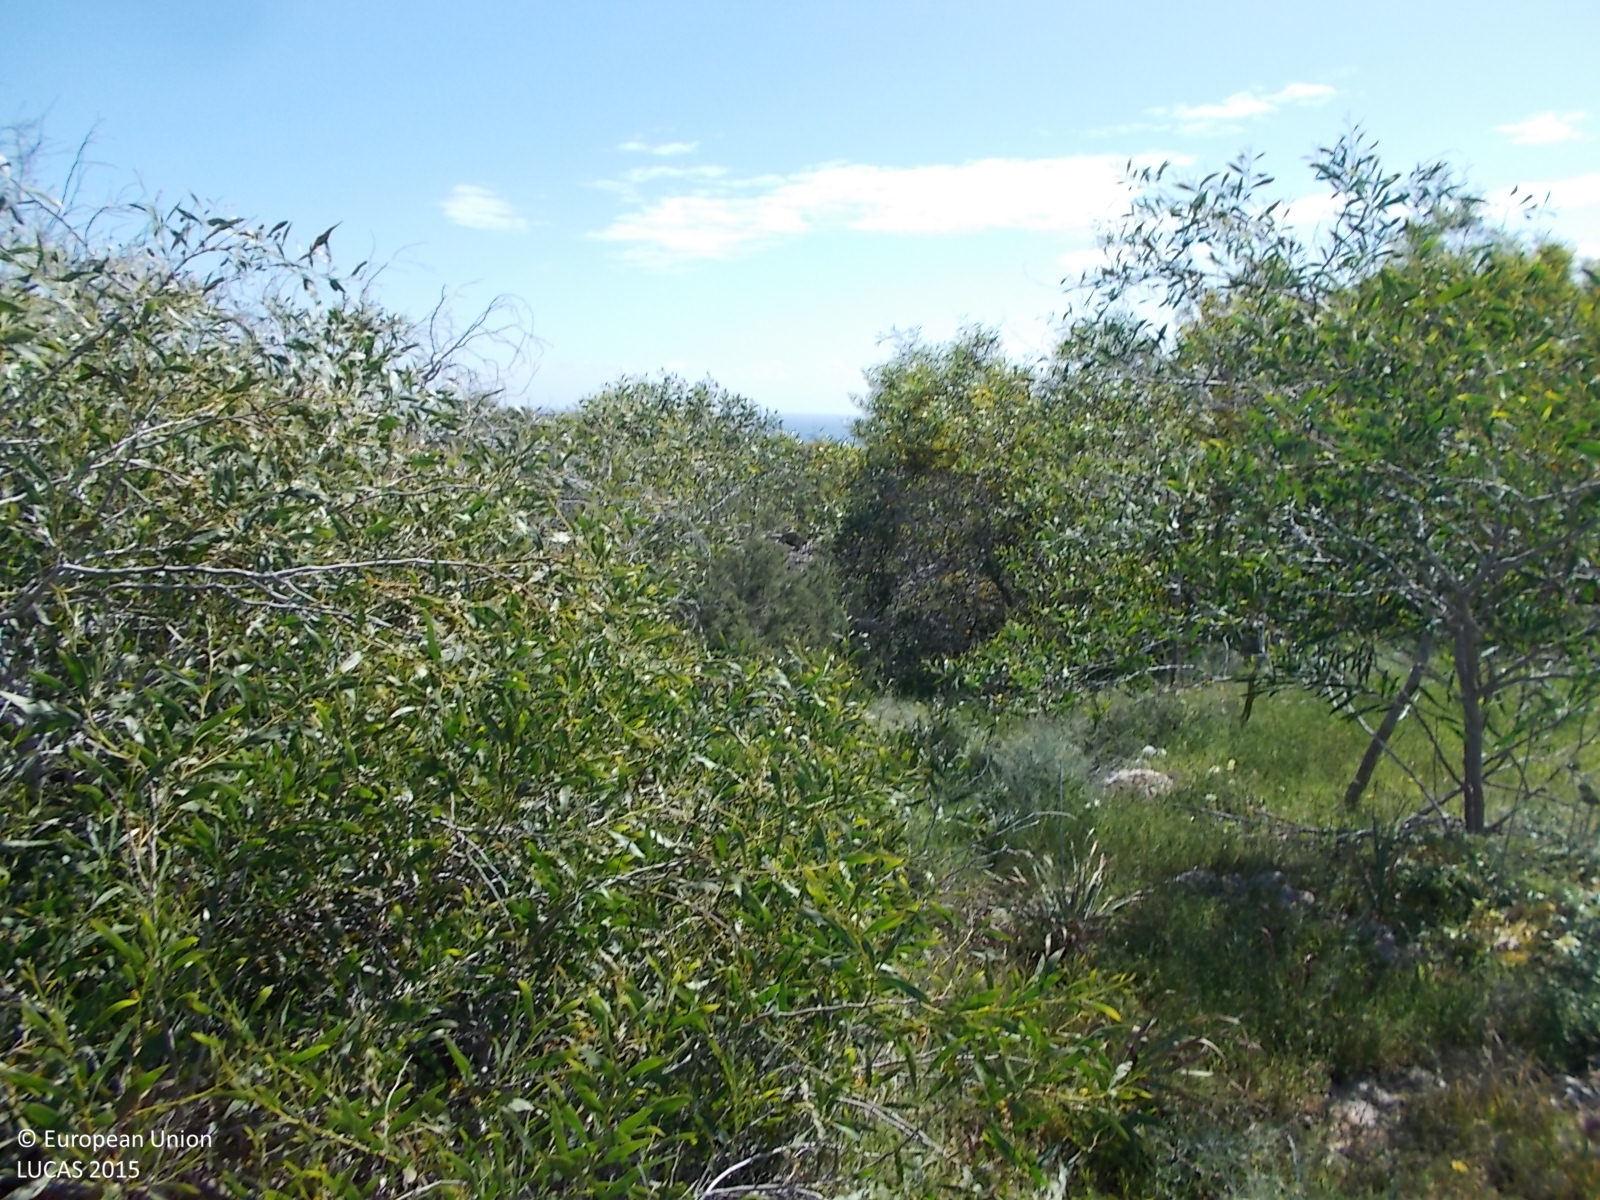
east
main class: Woodland
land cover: Broadleaved woodland
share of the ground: > 75 %
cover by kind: broadleaved forest trees 90 %, consolidated bare surface 5 %, unconsolidated bare surface 5 %
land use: Semi-natural and natural areas not in use
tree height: < 5 m
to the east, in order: Broadleaved woodland; Tracks; Artificial constructions in urban areas; Other bare soil; Broadleaved woodland; Tracks; Electric lines; Broadleaved woodland
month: March
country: CY
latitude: 35.0074
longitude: 34.0507
